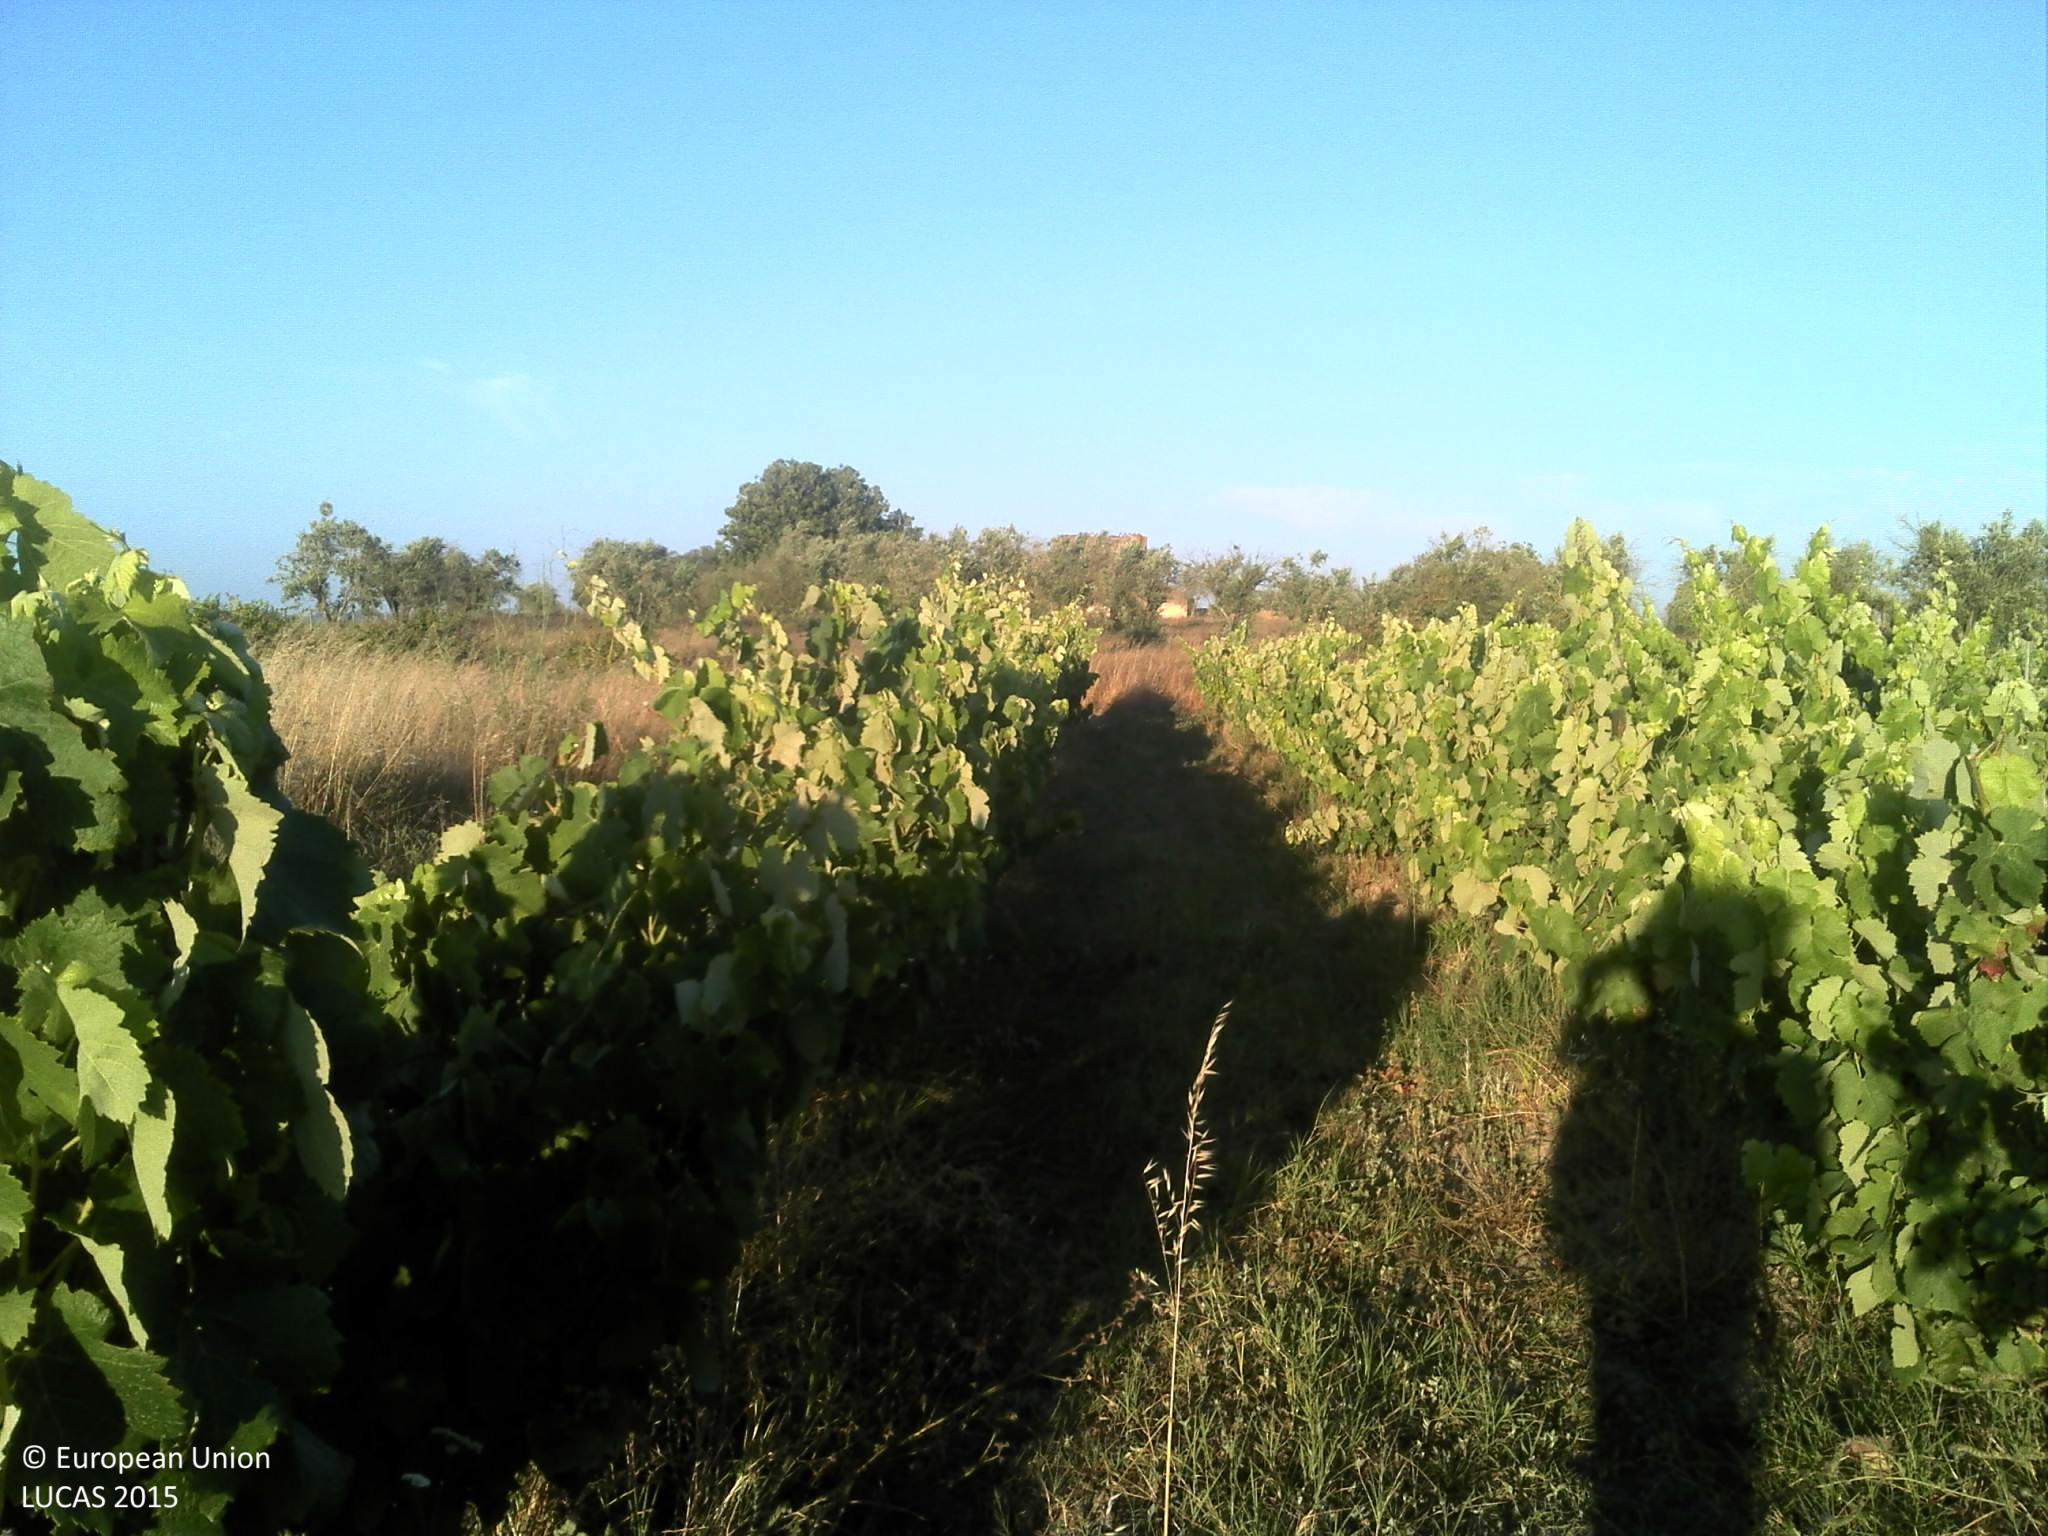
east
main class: Cropland
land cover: Vineyards
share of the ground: 25 - 50 %
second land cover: Grassland without tree/shrub cover
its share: 50 - 75 %
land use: Agriculture (excluding fallow land and kitchen gardens)
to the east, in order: Vineyards; Grassland without tree/shrub cover; Vineyards; Grassland without tree/shrub cover; Fences; Olive groves; Single bushes/trees; Olive groves
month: June
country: PT
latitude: 39.1170
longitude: -8.7032
